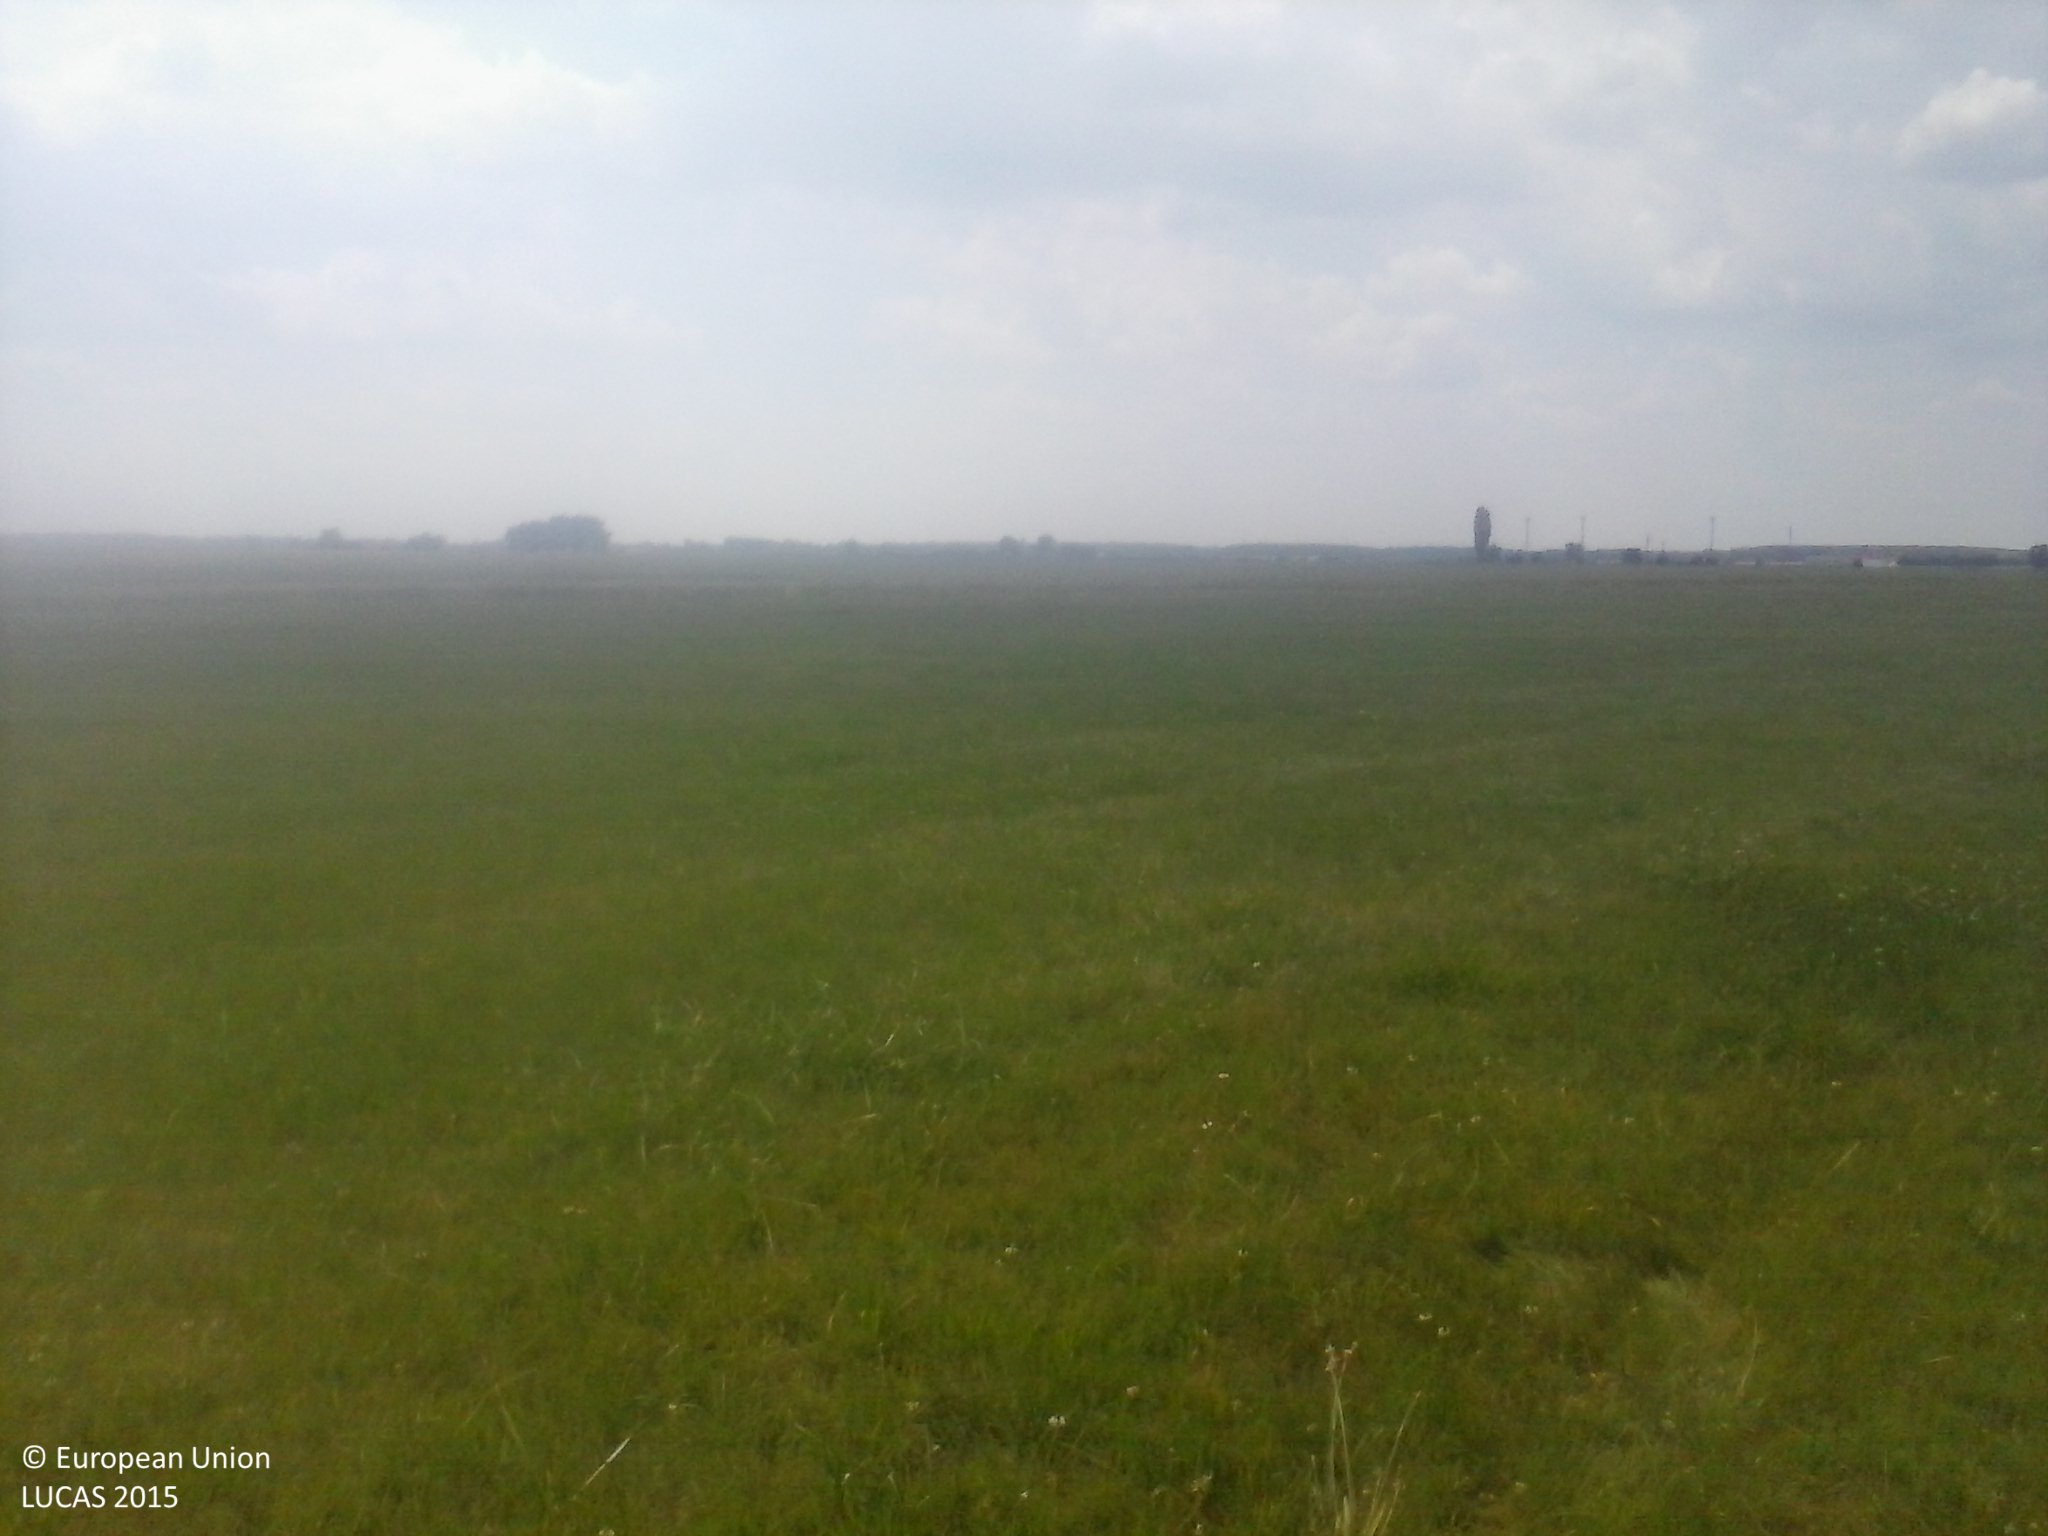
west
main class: Grassland
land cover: Grassland without tree/shrub cover
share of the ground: > 75 %
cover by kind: herbaceous plants 100 %
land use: Agriculture (excluding fallow land and kitchen gardens)
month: July
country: HU
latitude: 46.3633
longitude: 19.4921
